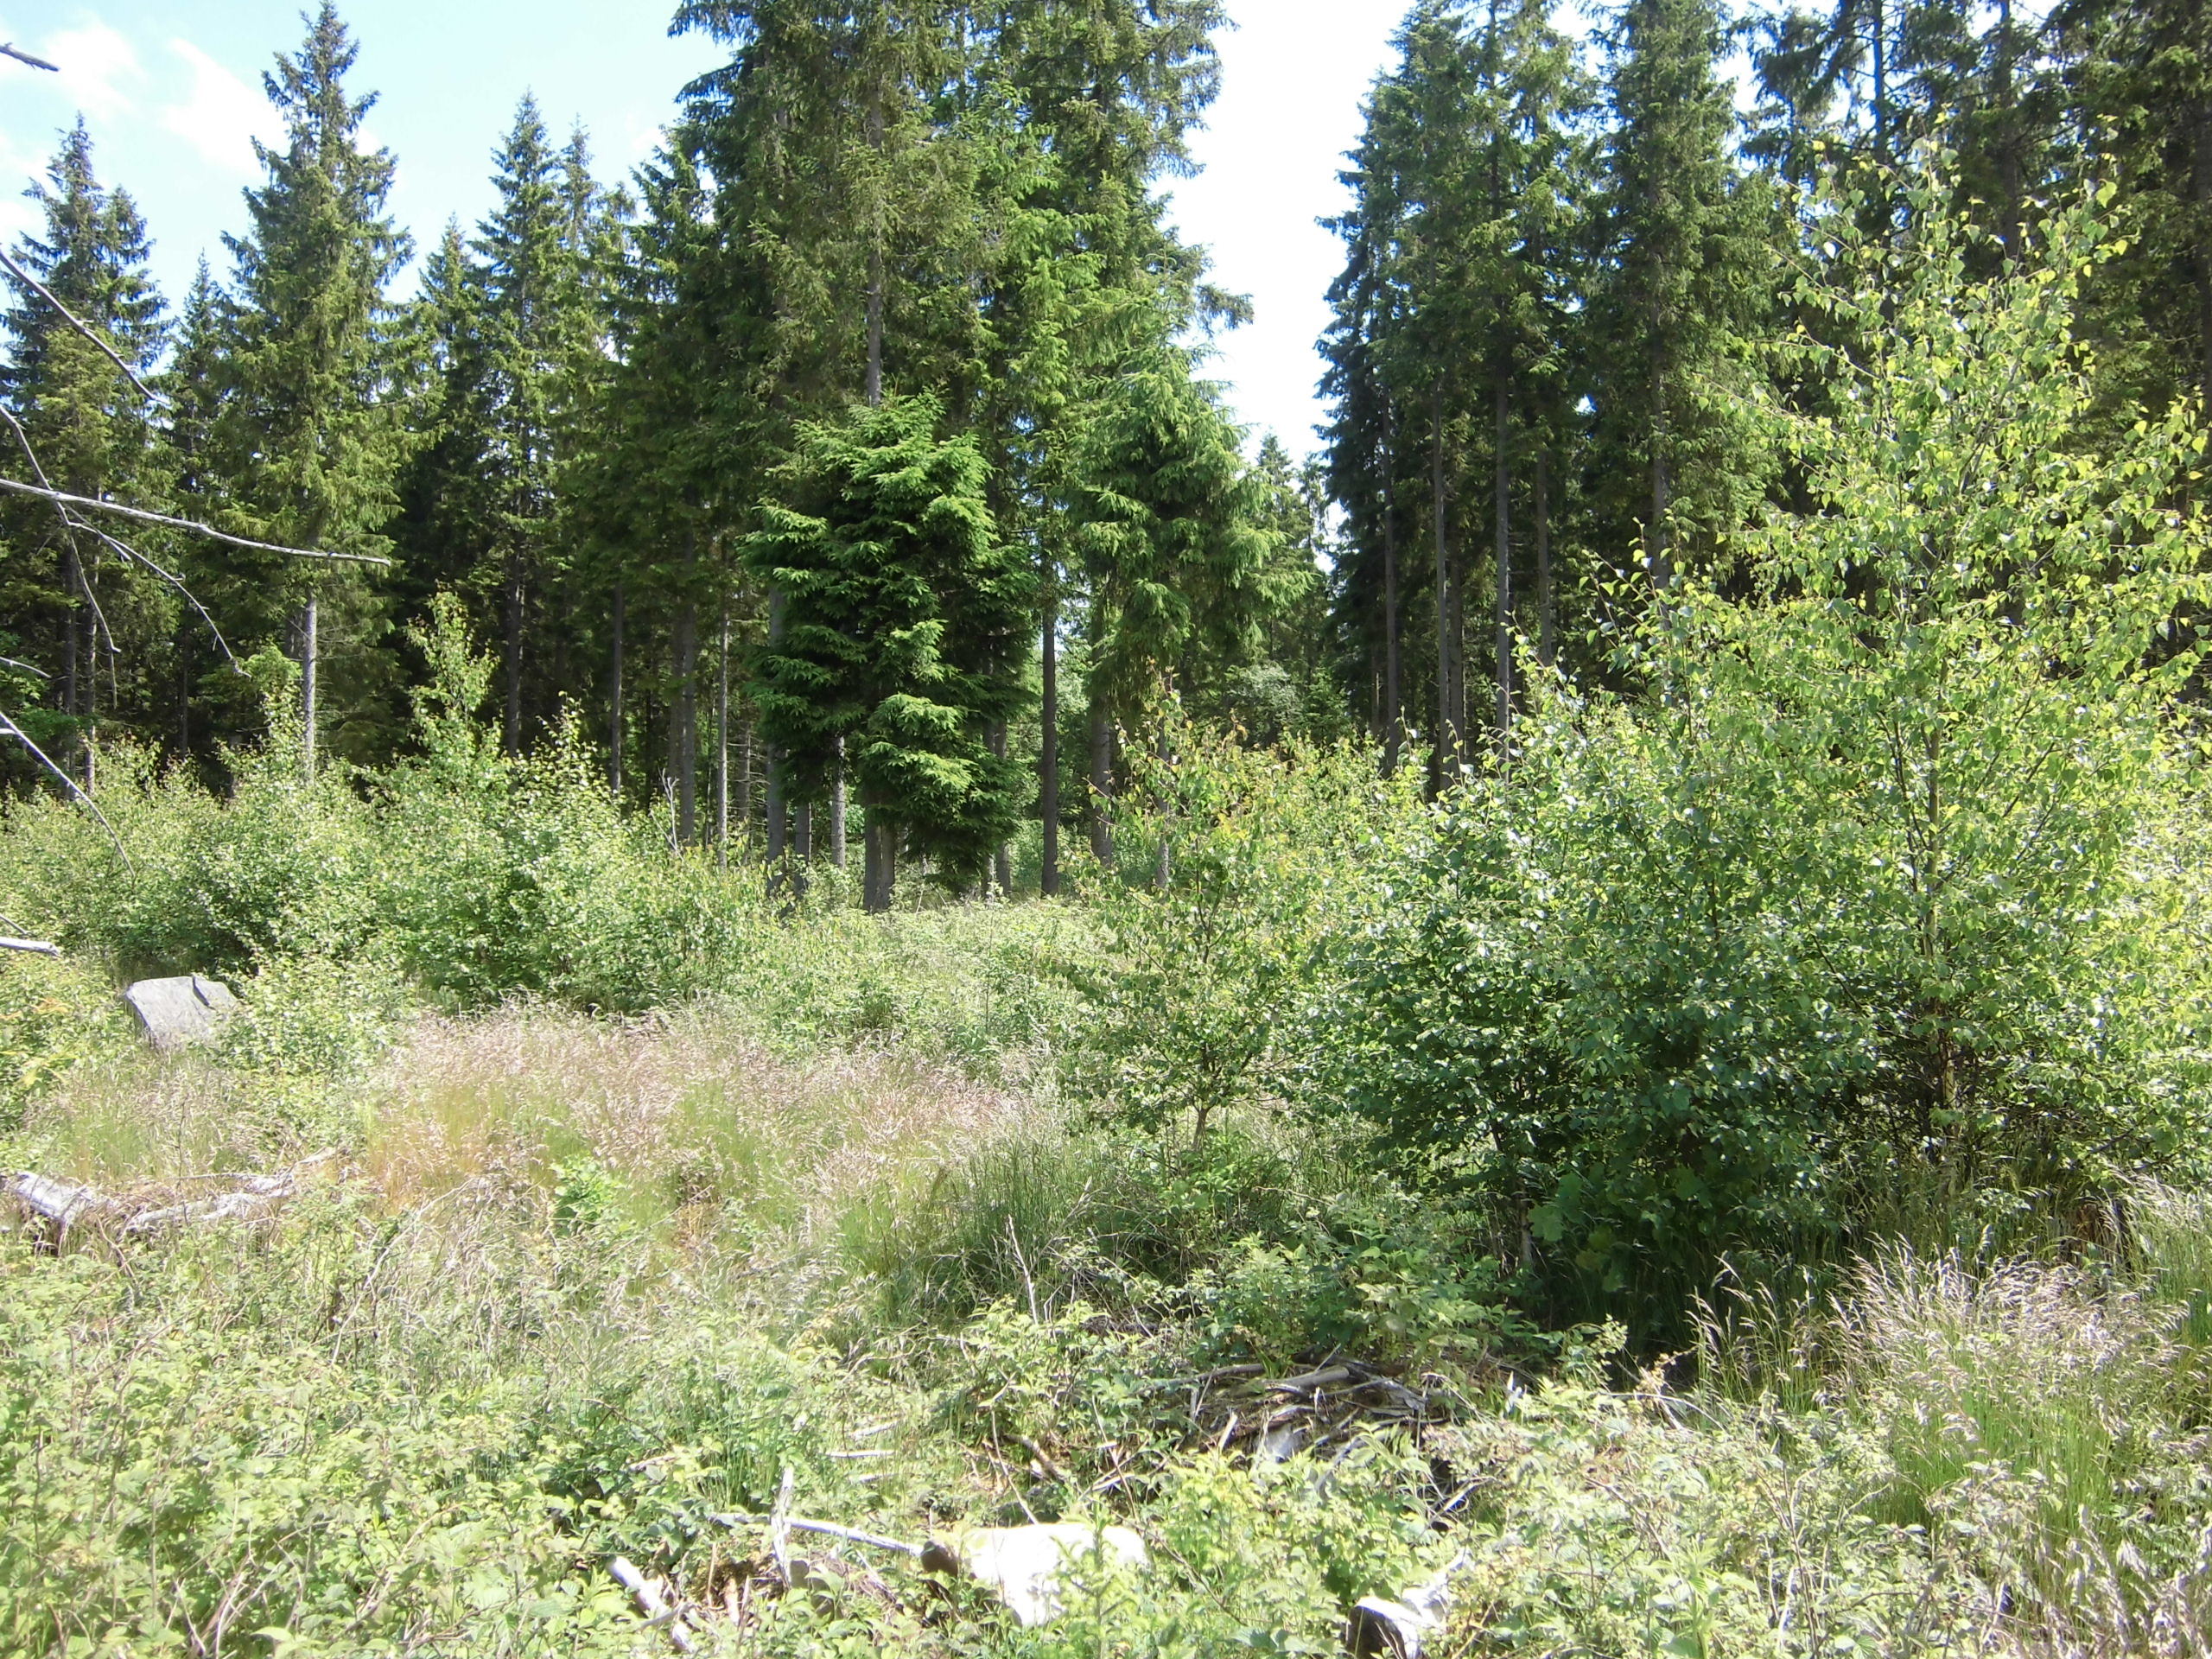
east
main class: Woodland
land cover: Broadleaved woodland
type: boreal forest
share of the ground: 50 - 75 %
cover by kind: broadleaved forest trees 50 %, herbaceous plants 20 %, shrubs 15 %, coniferous forest trees 5 %, lichens and mosses 5 %, unconsolidated bare surface 5 %
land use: Forestry
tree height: < 5 m
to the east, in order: Broadleaved woodland; Spruce dominated coniferous woodland; Spruce dominated mixed woodland; Ditches and canals; Spruce dominated coniferous woodland
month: June
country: SE
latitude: 57.0362
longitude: 14.7591
